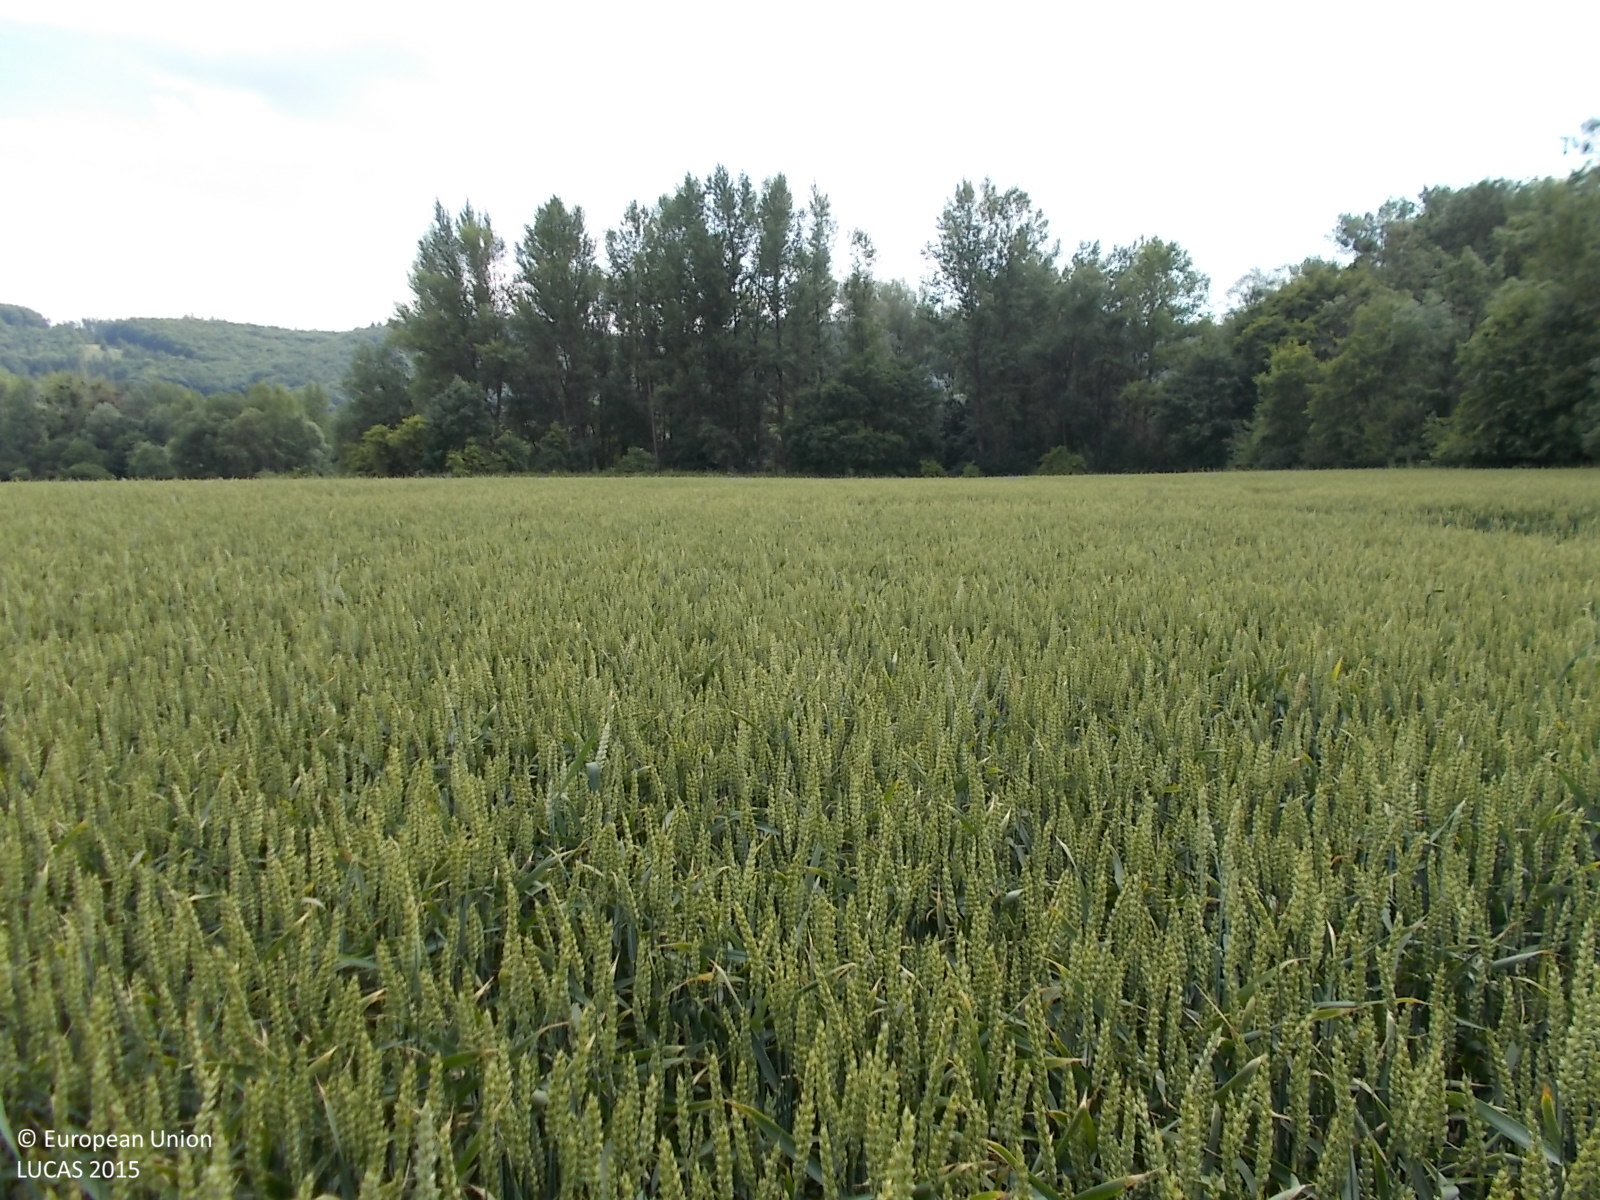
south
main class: Cropland
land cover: Common wheat
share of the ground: > 75 %
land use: Agriculture (excluding fallow land and kitchen gardens)
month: June
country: CZ
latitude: 49.5435
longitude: 17.7112
